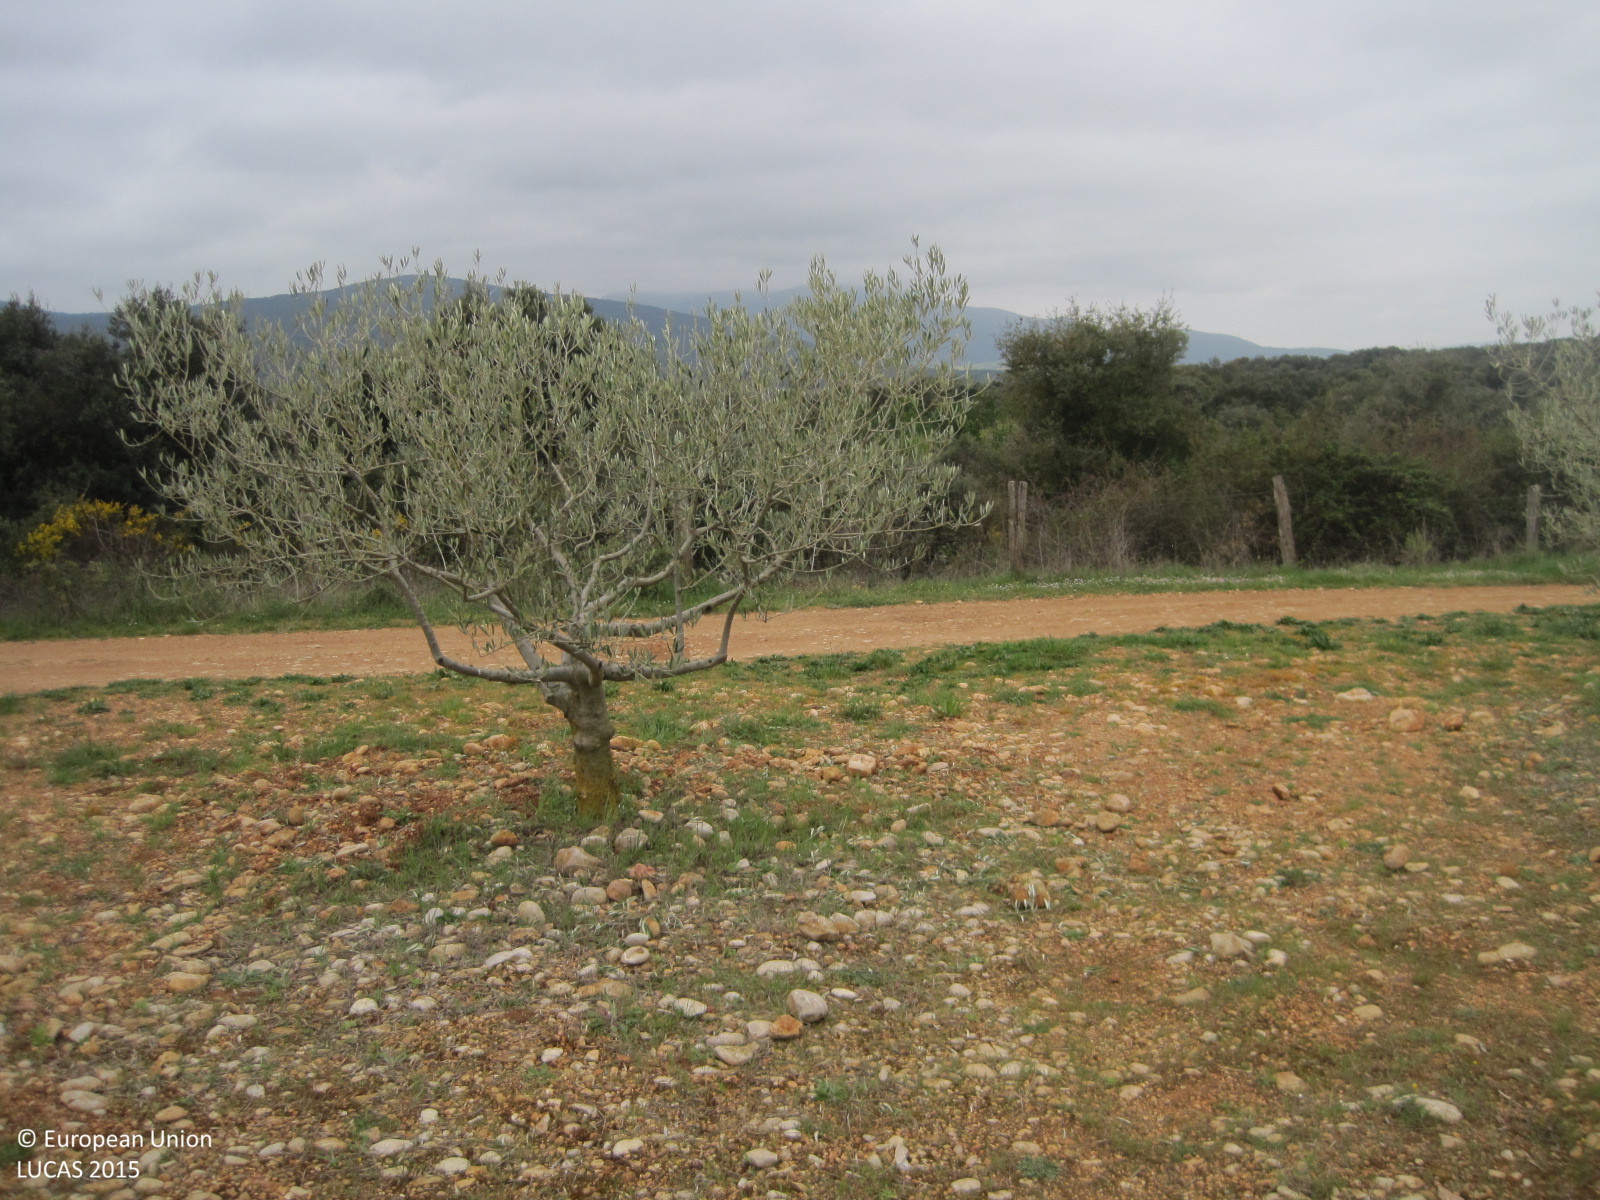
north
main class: Cropland
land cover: Olive groves
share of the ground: 10 - 25 %
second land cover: Grassland without tree/shrub cover
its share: > 75 %
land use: Agriculture (excluding fallow land and kitchen gardens)
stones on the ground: > 50 %
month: April
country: ES
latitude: 42.6635
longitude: -2.1830
